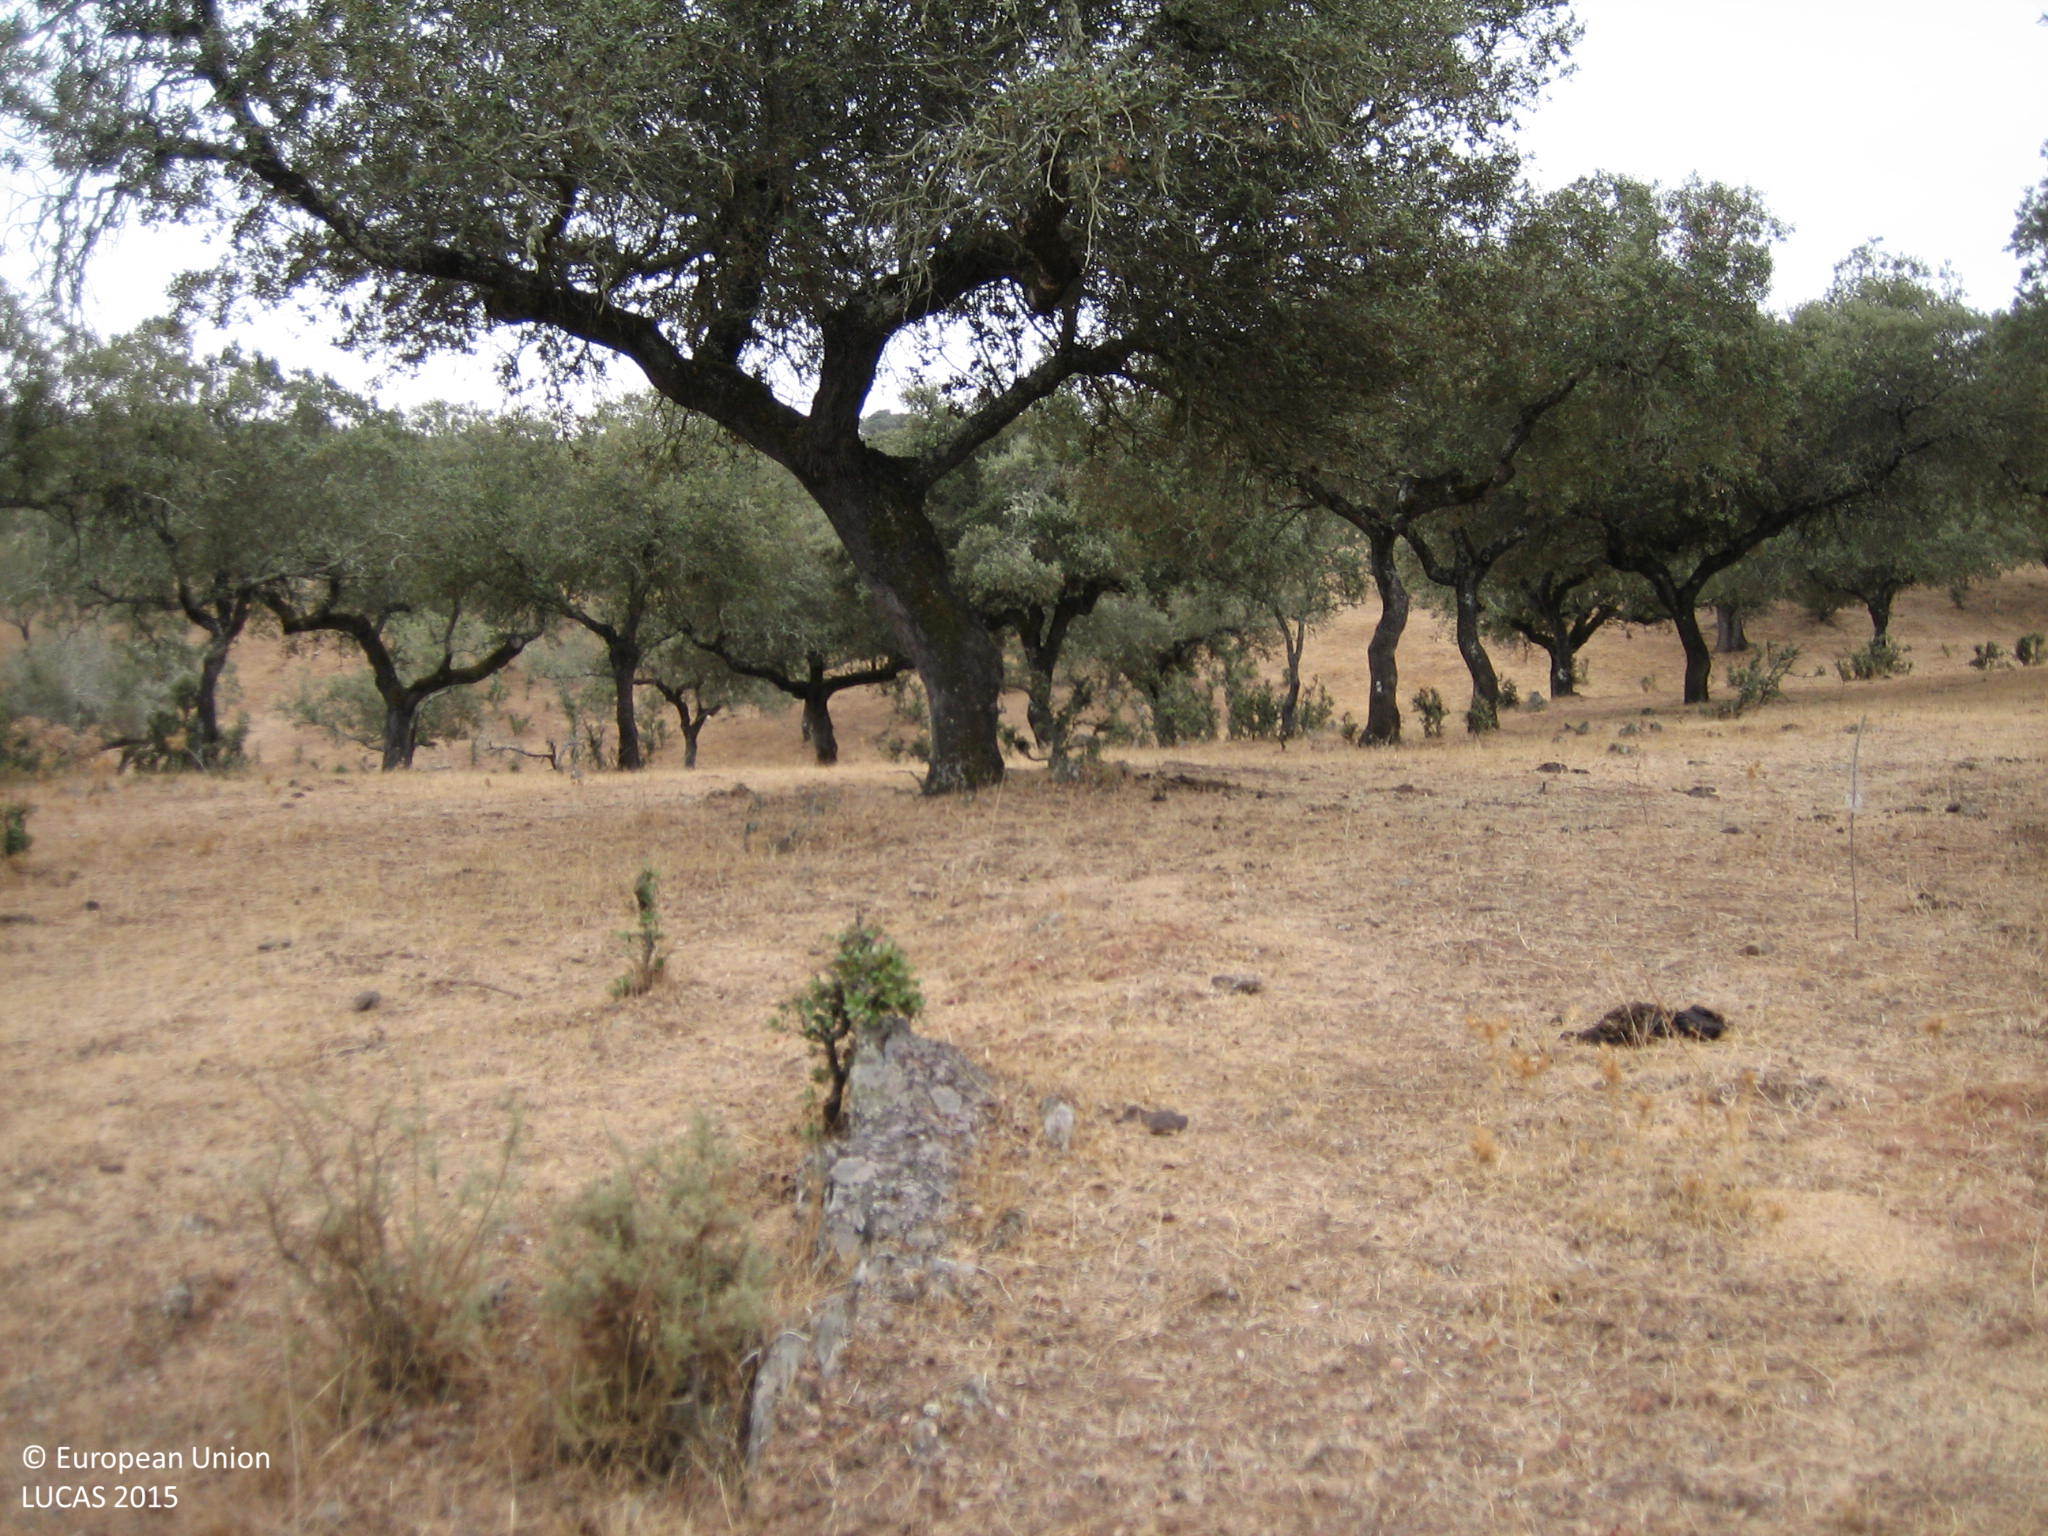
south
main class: Woodland
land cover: Broadleaved woodland
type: broadleaved evergreen forest
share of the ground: 25 - 50 %
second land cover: Grassland without tree/shrub cover
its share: > 75 %
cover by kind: herbaceous plants 60 %, broadleaved forest trees 40 %
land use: Forestry
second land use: Agriculture (excluding fallow land and kitchen gardens)
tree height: > 5 m
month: September
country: ES
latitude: 38.3177
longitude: -7.1626
